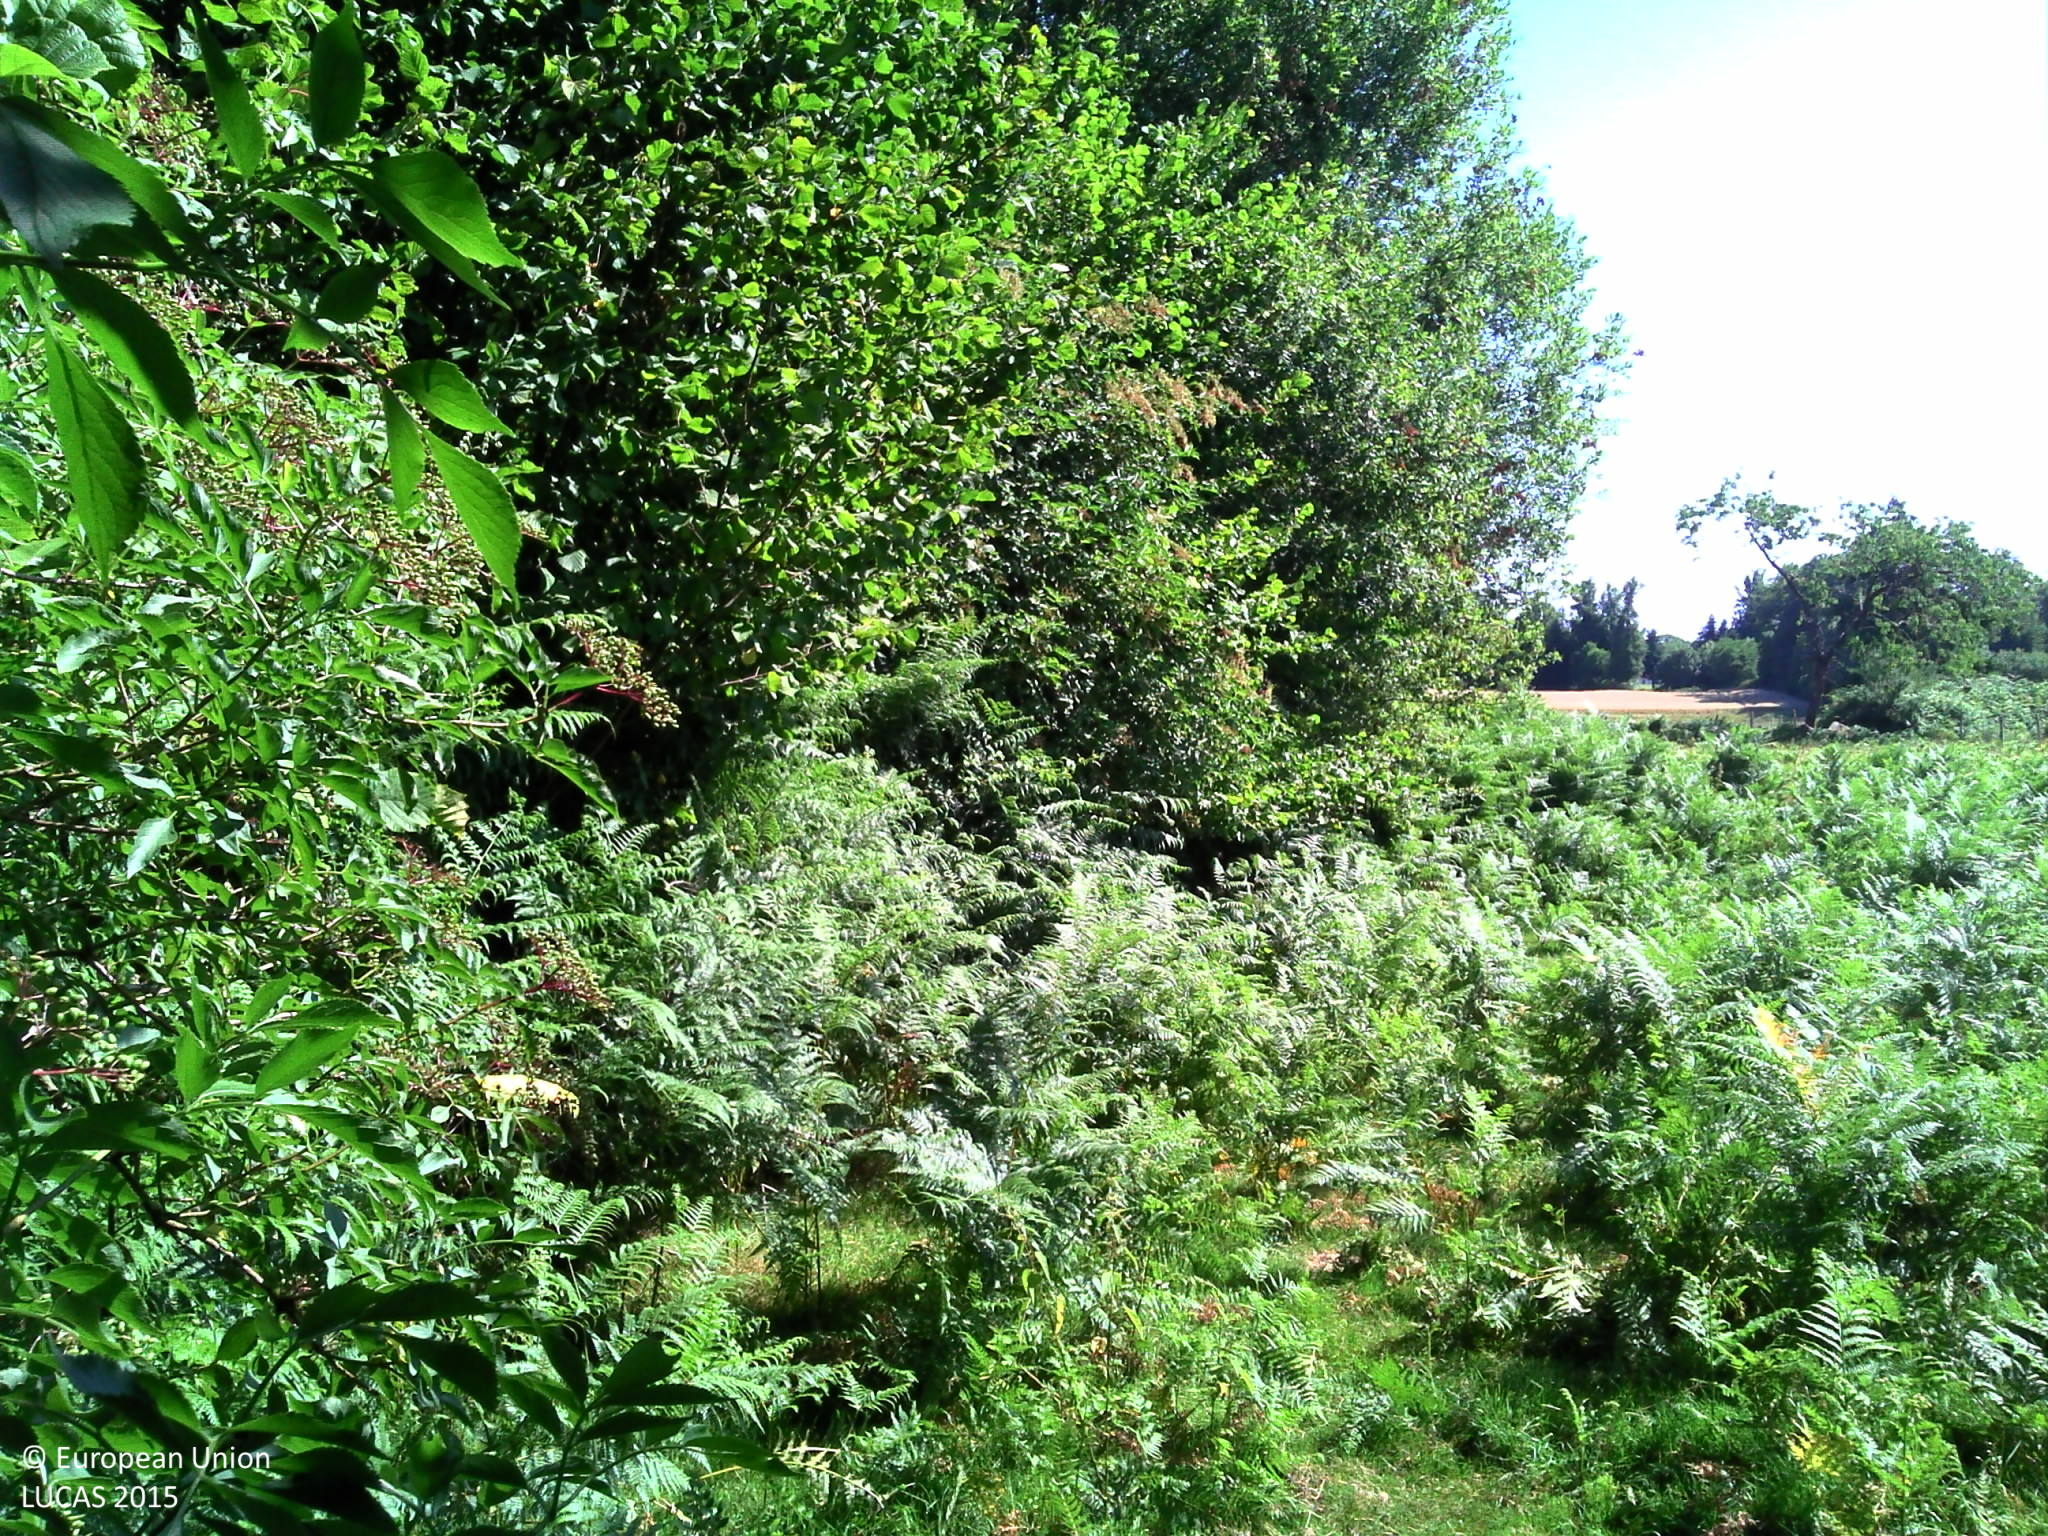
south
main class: Woodland
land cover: Broadleaved woodland
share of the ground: > 75 %
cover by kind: broadleaved forest trees 90 %, shrubs 10 %
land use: Semi-natural and natural areas not in use
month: June
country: FR
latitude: 45.7408
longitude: 0.6432
